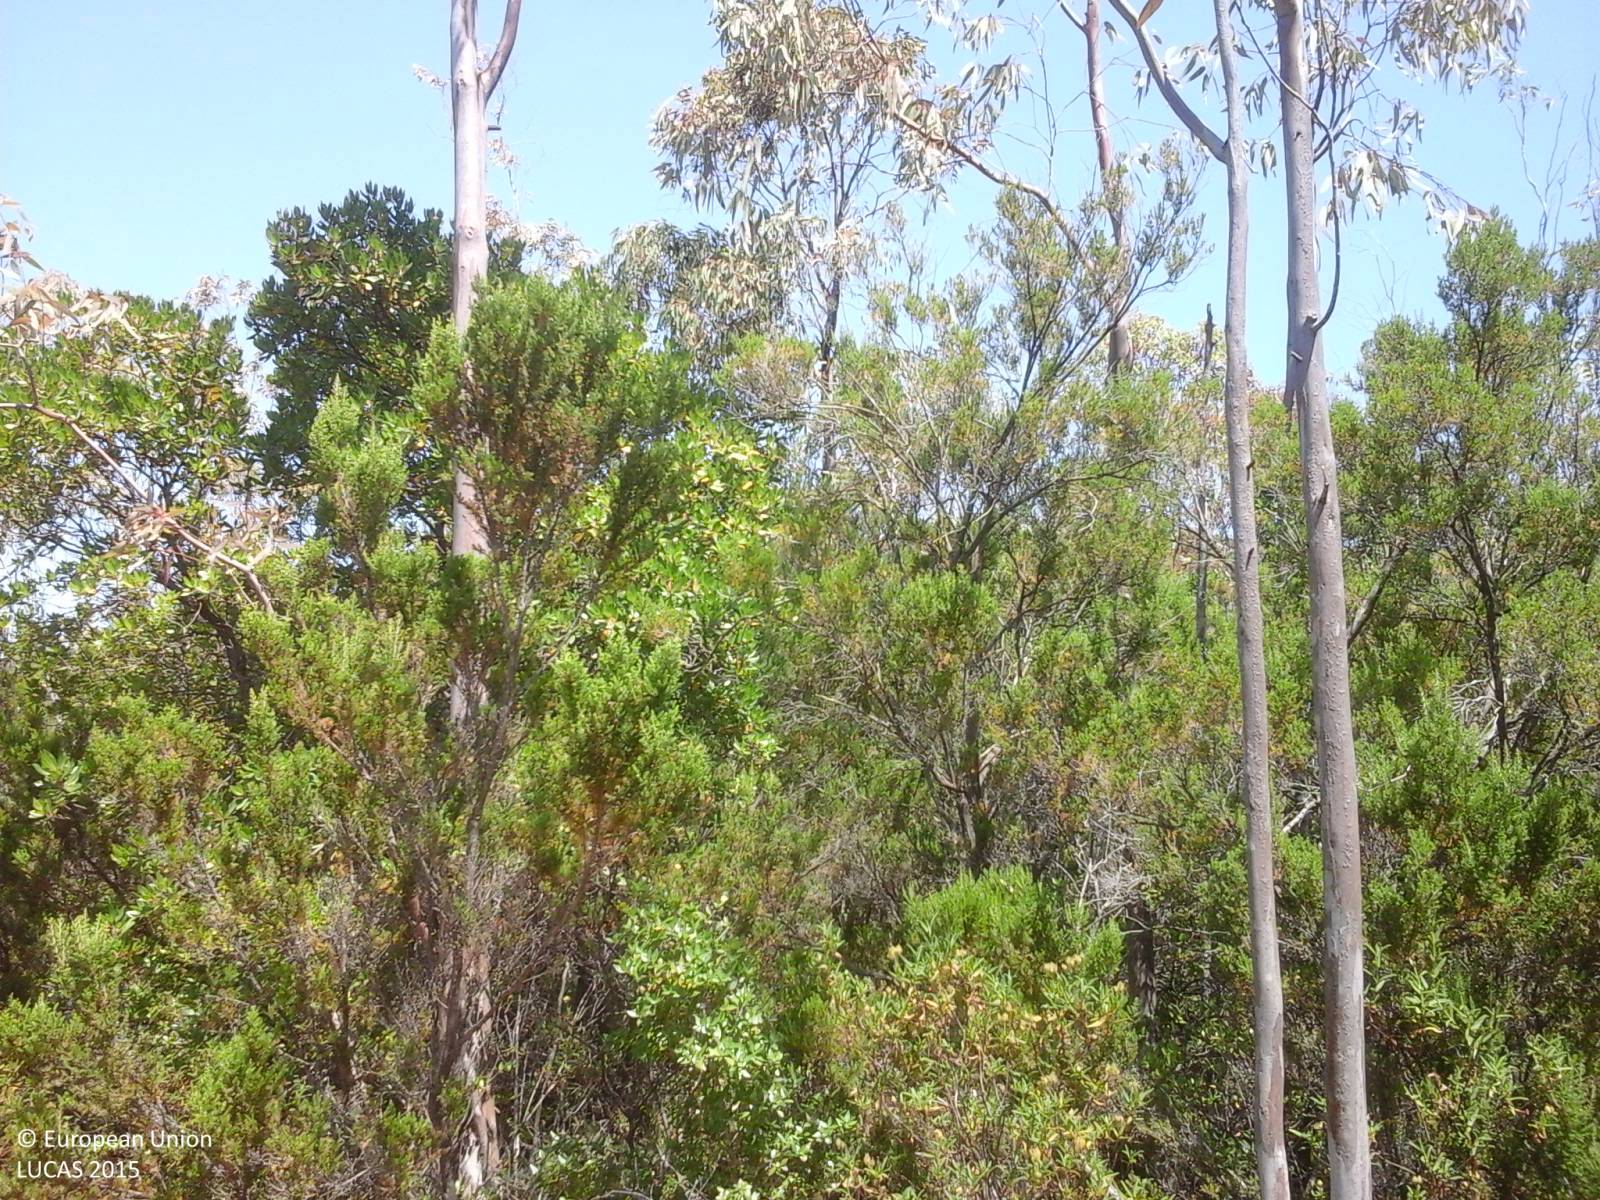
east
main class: Shrubland
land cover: Shrubland with sparse tree cover
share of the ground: > 75 %
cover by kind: shrubs 95 %, broadleaved forest trees 5 %
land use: Semi-natural and natural areas not in use
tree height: < 5 m
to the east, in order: Shrubland with sparse tree cover; Tracks; Shrubland with sparse tree cover; Broadleaved woodland; Tracks; Shrubland with sparse tree cover
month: June
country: IT
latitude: 39.2098
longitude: 8.8376
